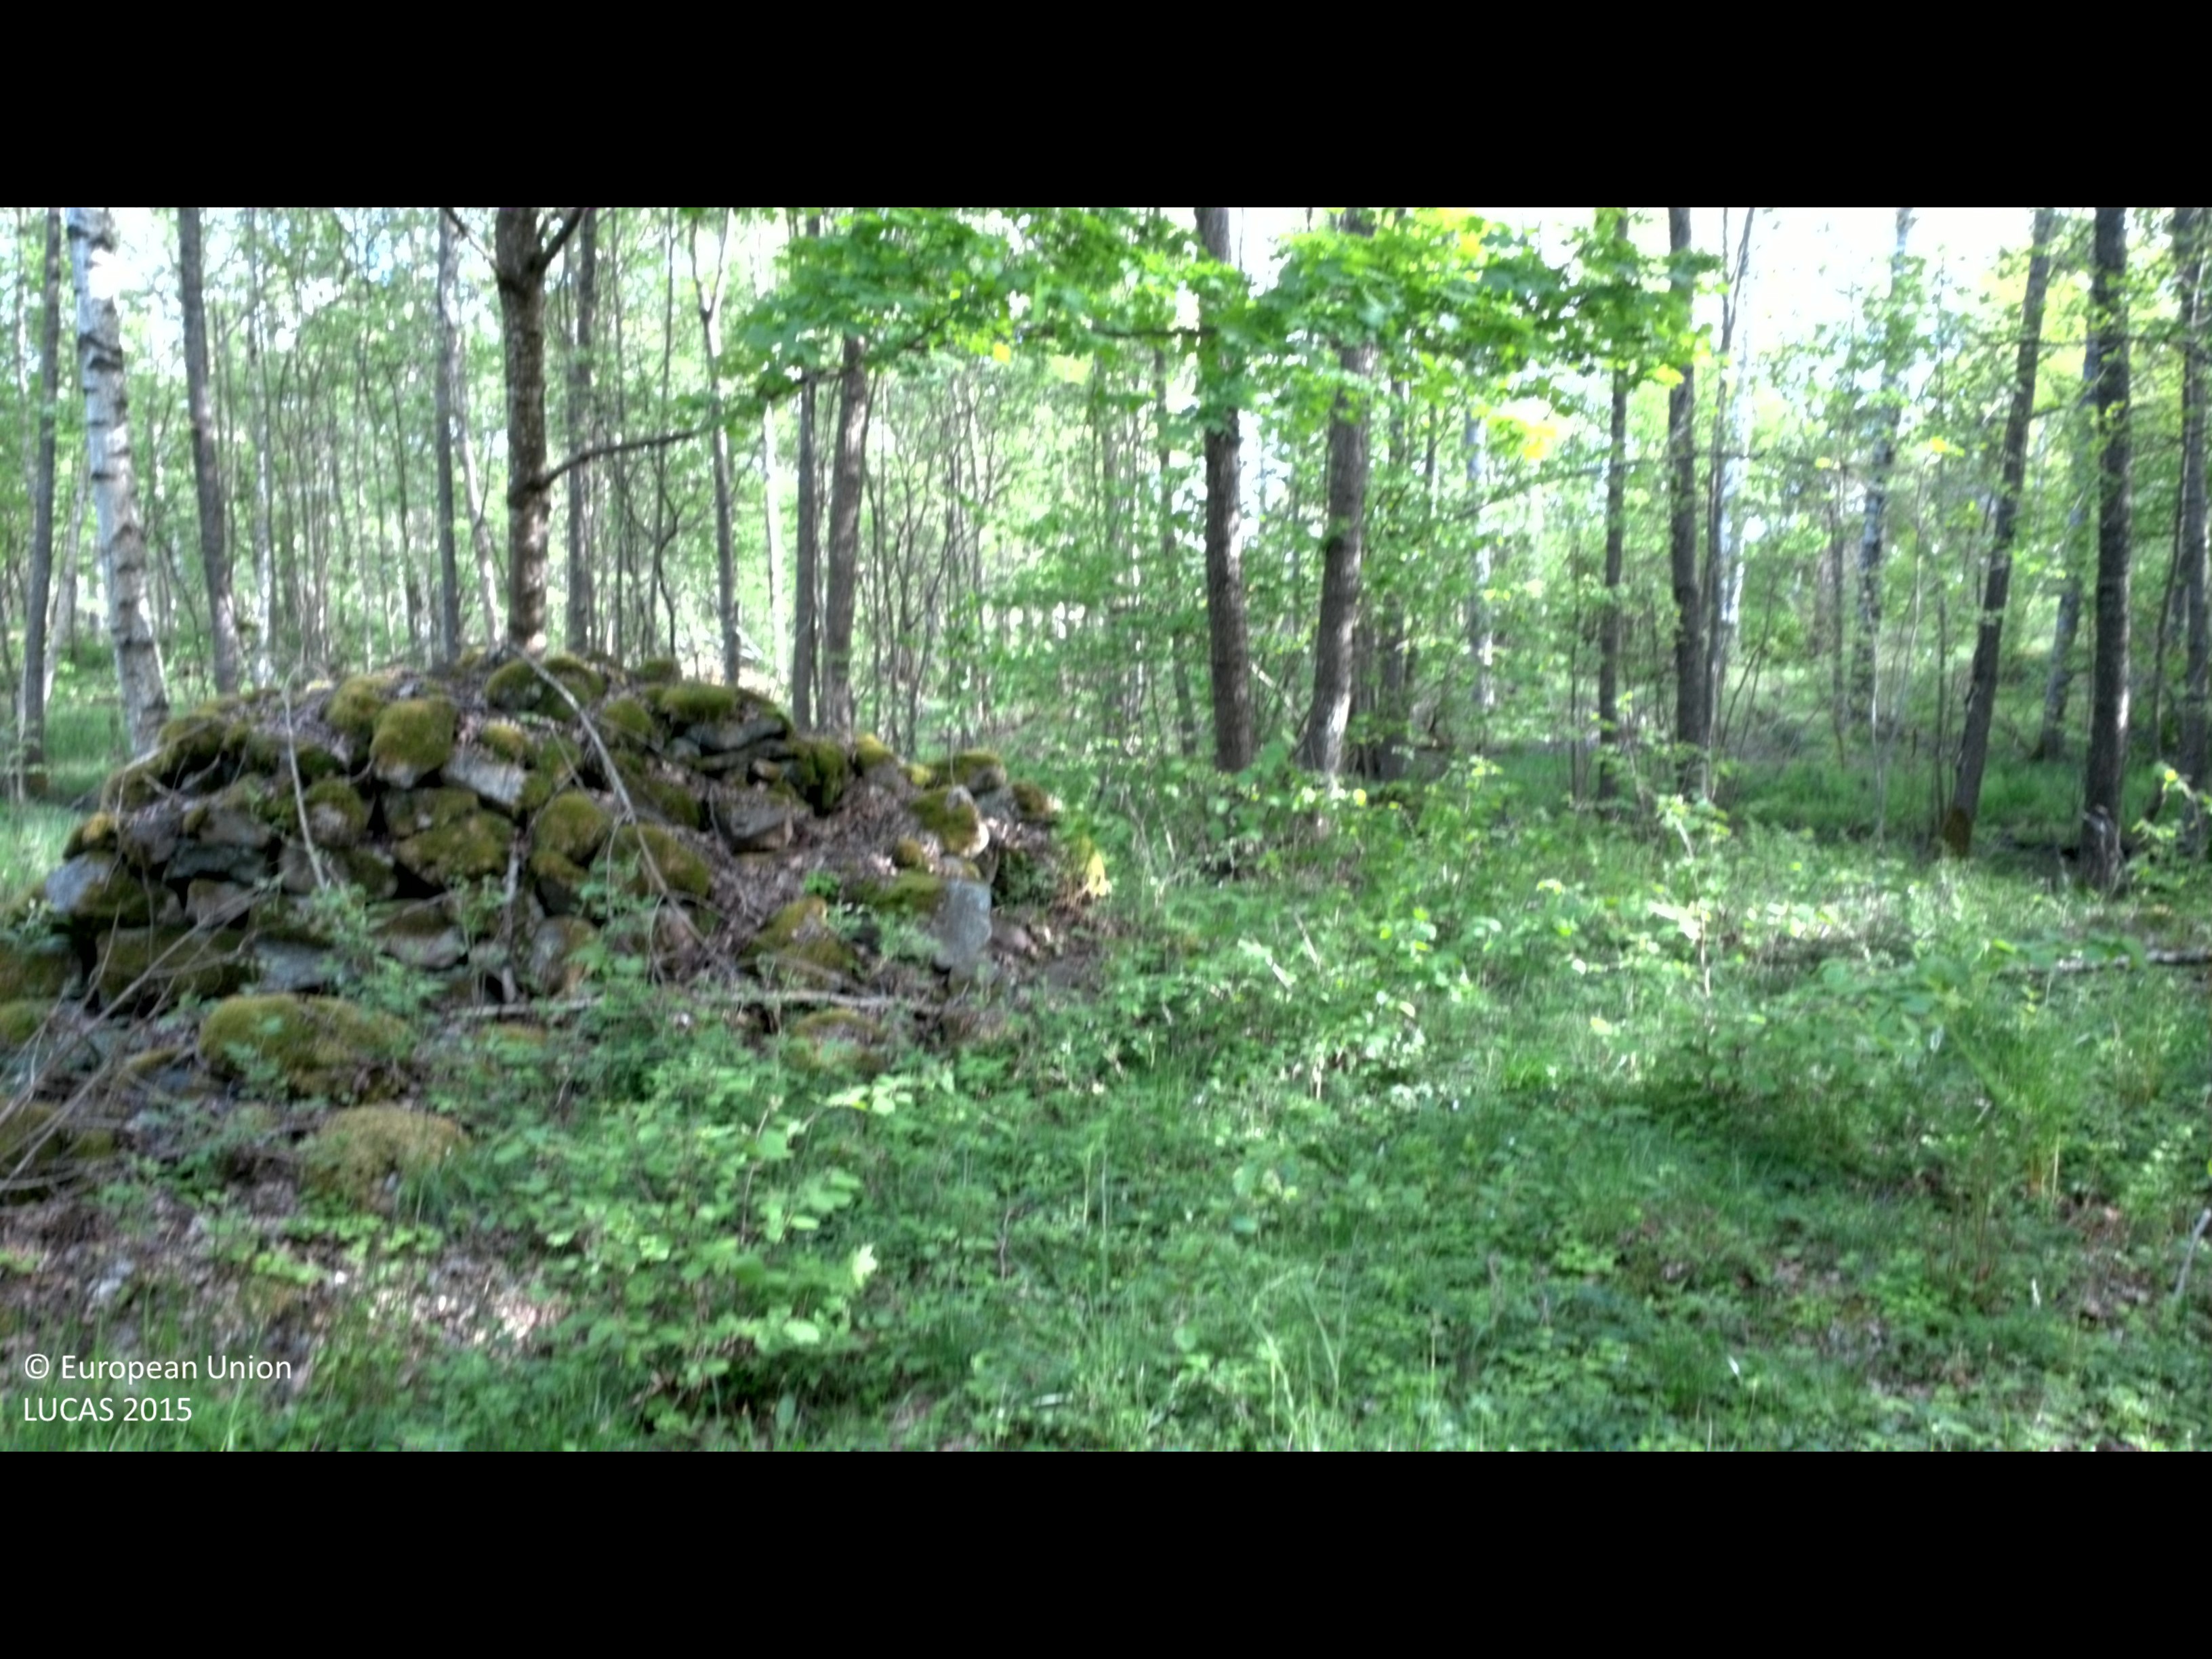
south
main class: Woodland
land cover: Broadleaved woodland
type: non-riverine alder, birch or aspen forest
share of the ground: 25 - 50 %
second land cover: Grassland without tree/shrub cover
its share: 50 - 75 %
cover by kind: herbaceous plants 50 %, broadleaved forest trees 45 %, shrubs 5 %
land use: Forestry
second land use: Agriculture (excluding fallow land and kitchen gardens)
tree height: > 5 m
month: May
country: SE
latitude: 57.3579
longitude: 16.1323
